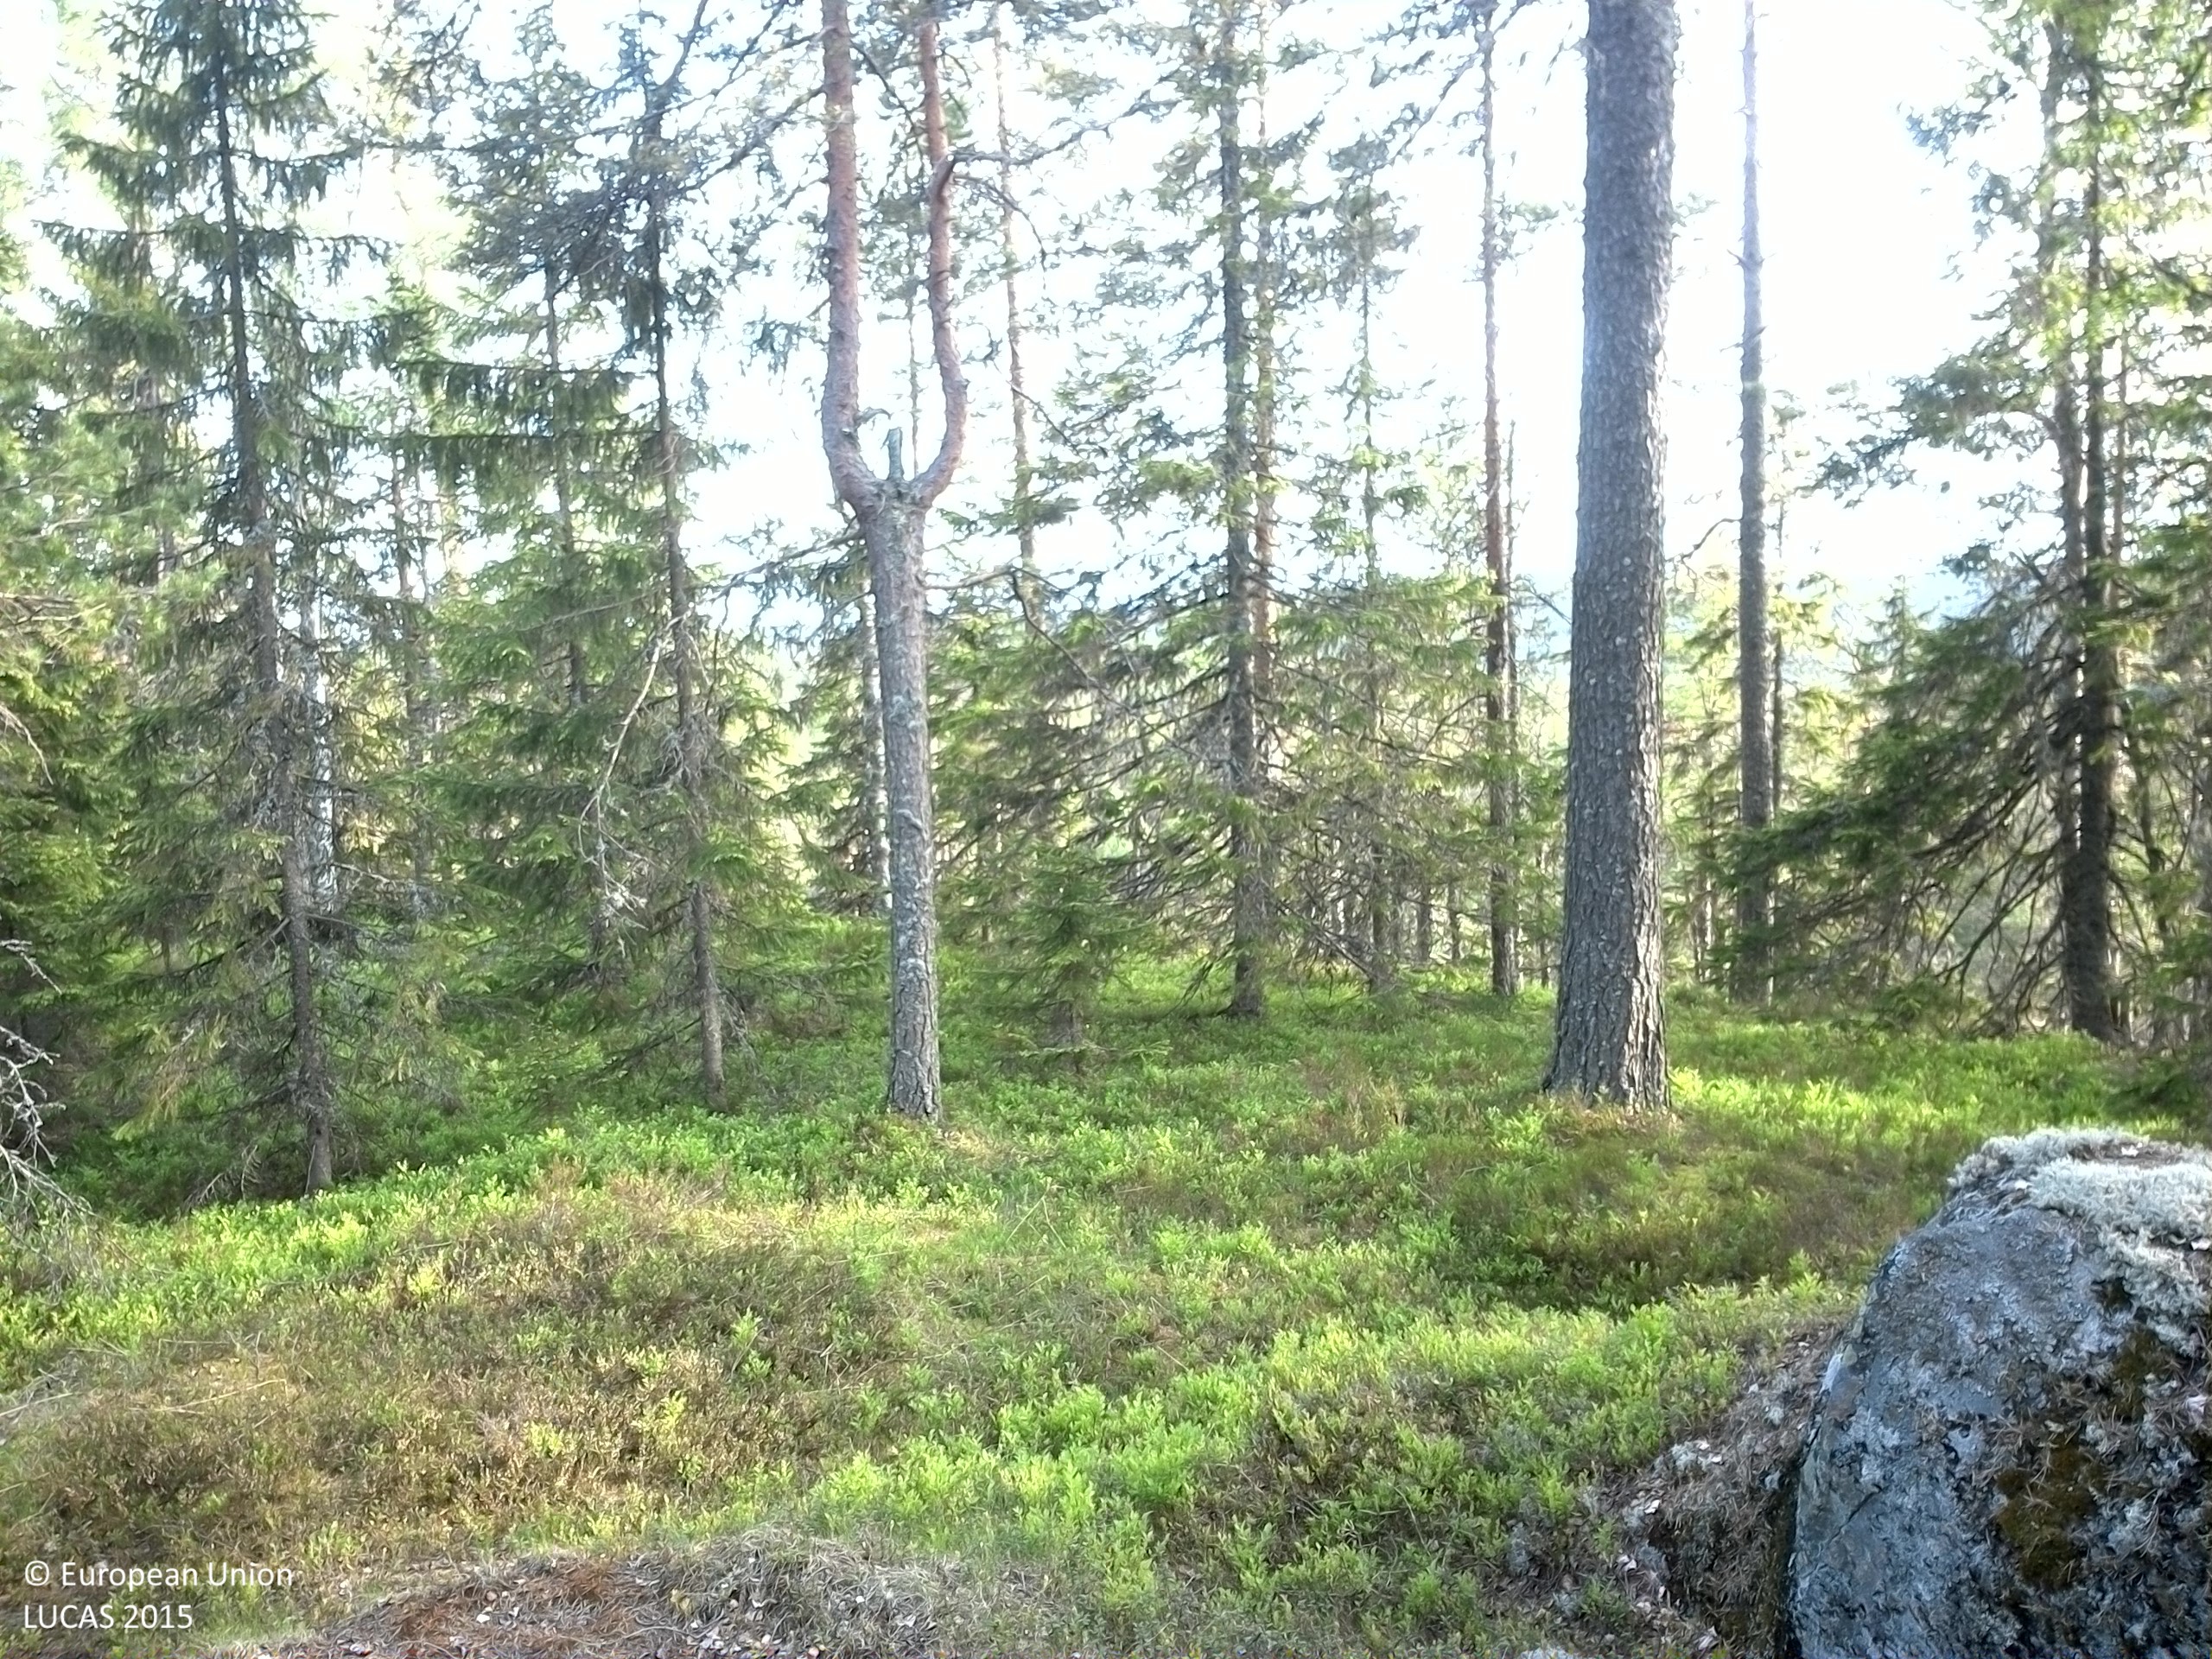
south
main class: Woodland
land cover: Other coniferous woodland
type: boreal forest
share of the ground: 25 - 50 %
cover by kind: shrubs 60 %, coniferous forest trees 25 %, lichens and mosses 10 %, broadleaved forest trees 5 %
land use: Forestry
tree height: > 5 m
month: June
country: SE
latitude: 62.6395
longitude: 17.5664
